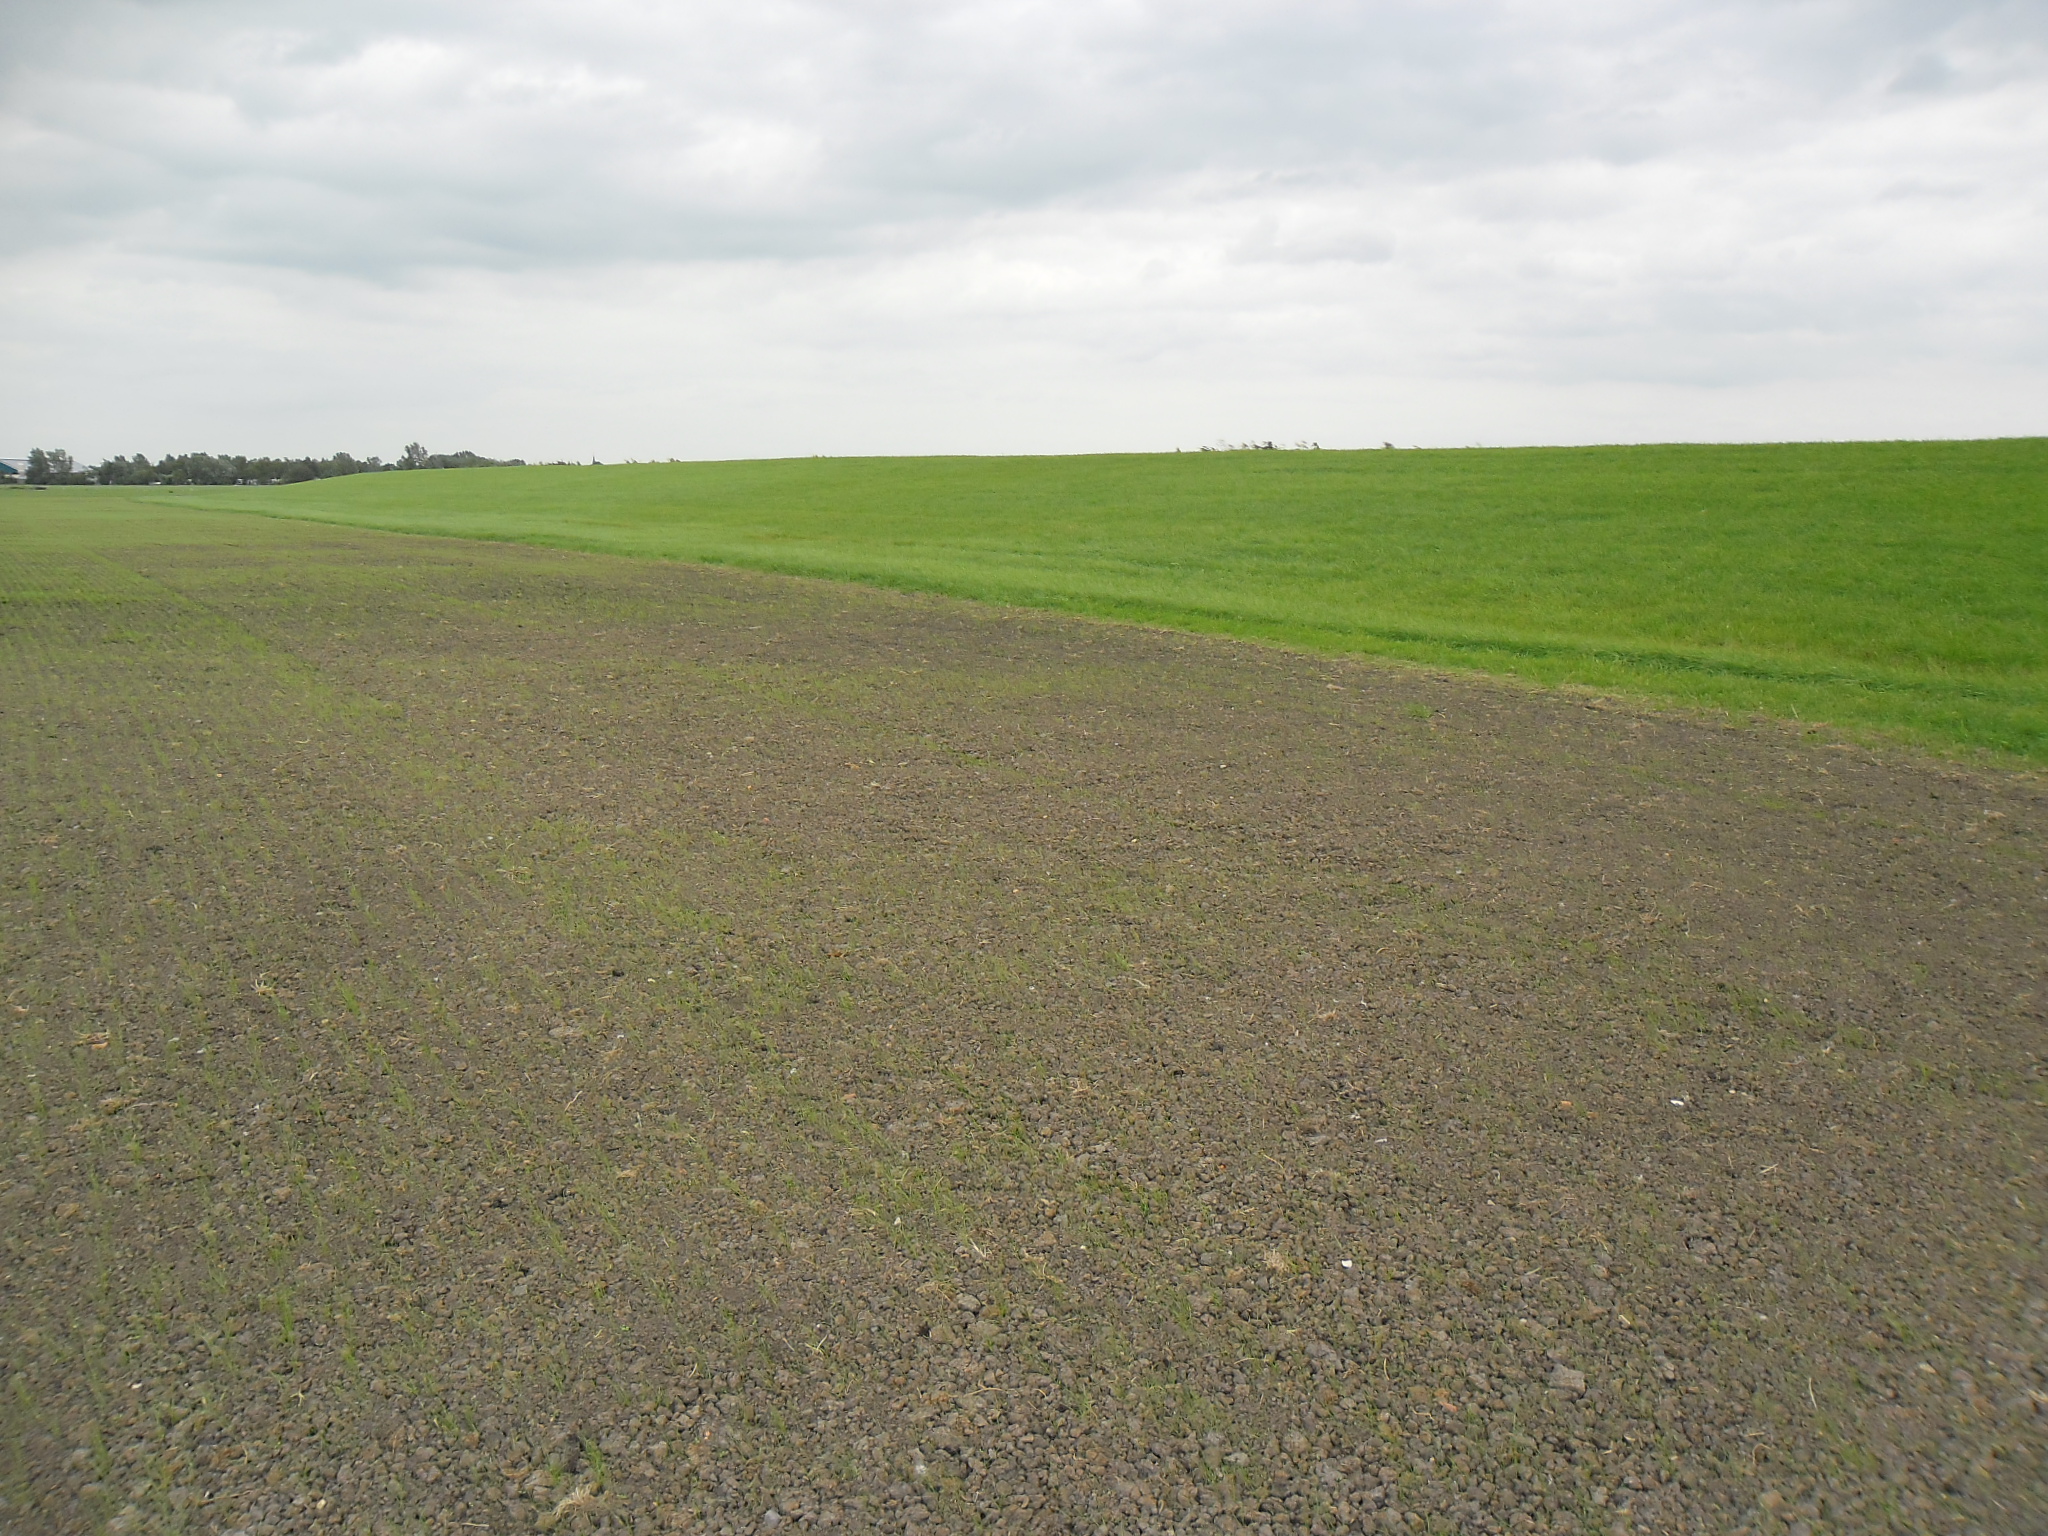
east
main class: Grassland
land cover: Grassland without tree/shrub cover
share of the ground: < 10 %
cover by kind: consolidated bare surface 90 %, herbaceous plants 10 %
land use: Agriculture (excluding fallow land and kitchen gardens)
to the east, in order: Grassland without tree/shrub cover; Spontaneously vegetated surfaces; Inland fresh water bodies
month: August
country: NL
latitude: 52.9612
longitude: 5.5773
